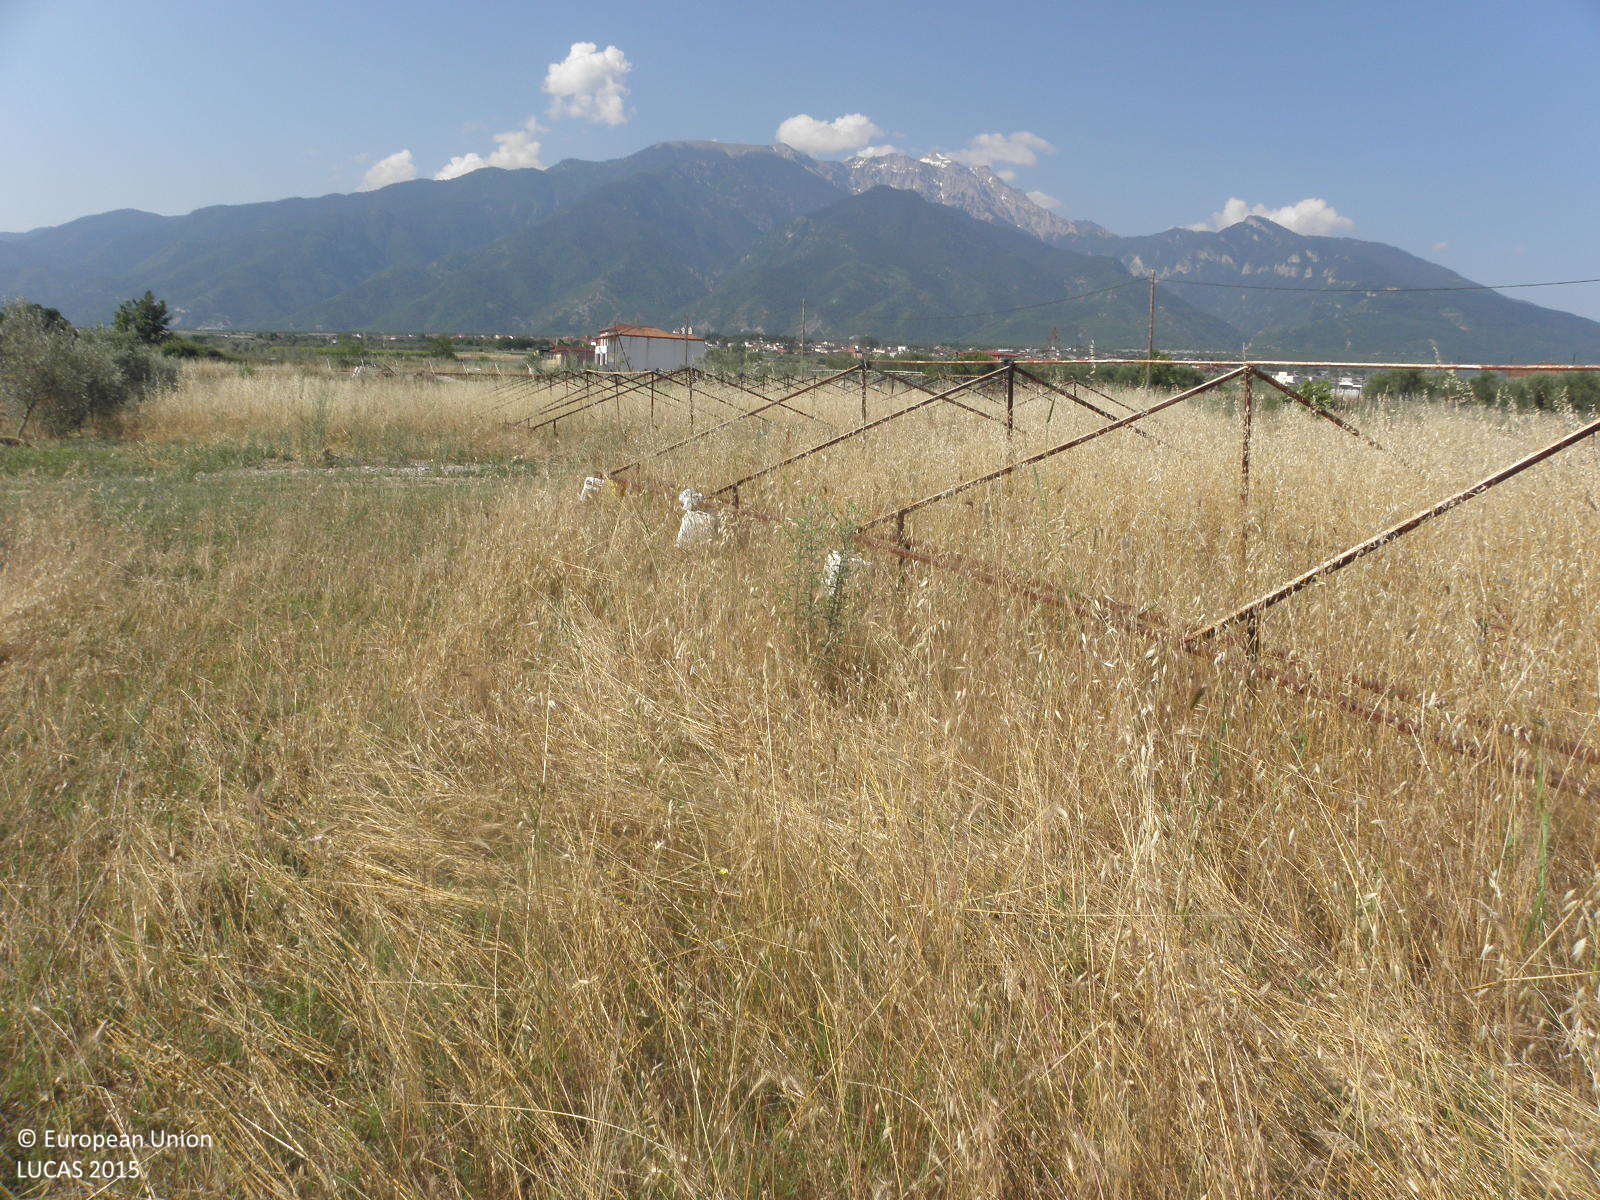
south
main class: Grassland
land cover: Spontaneously vegetated surfaces
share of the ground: > 75 %
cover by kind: herbaceous plants 100 %
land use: Fallow land
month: June
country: GR
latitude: 40.2038
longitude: 22.4381
